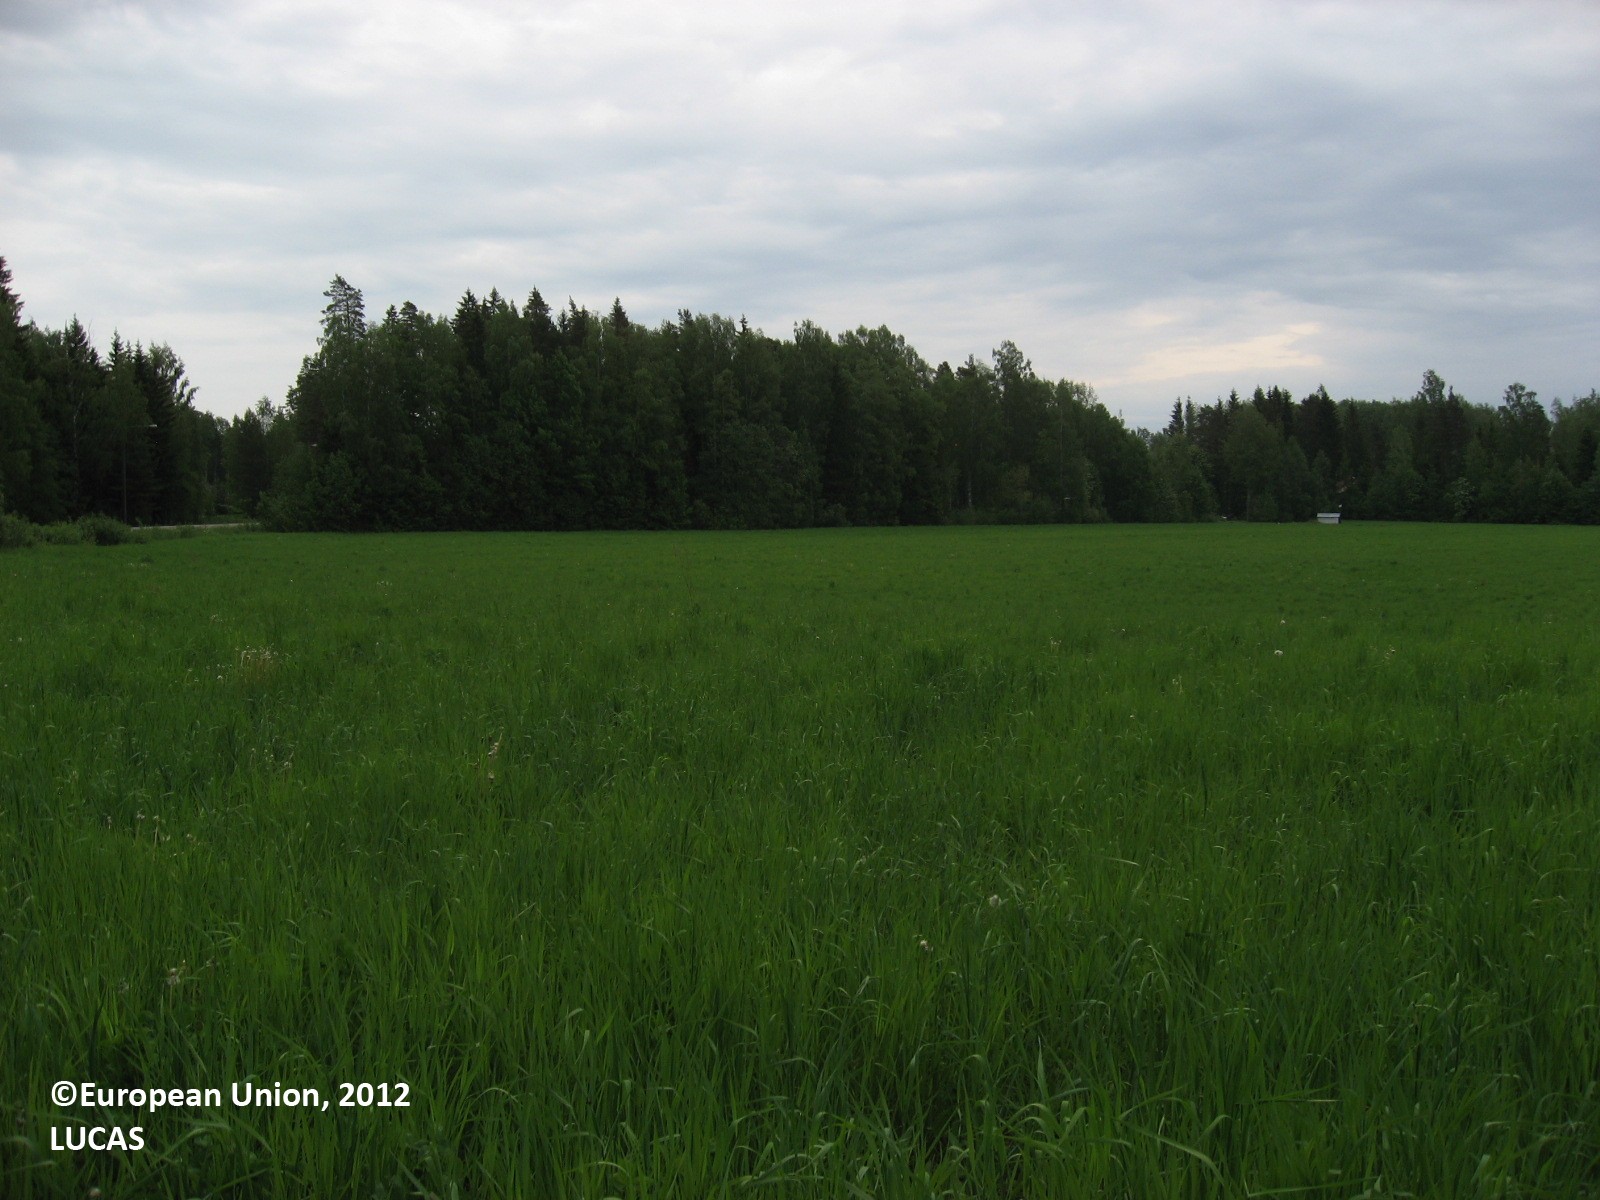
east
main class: Cropland
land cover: Other leguminous and mixtures for fodder
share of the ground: > 75 %
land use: Agriculture (excluding fallow land and kitchen gardens)
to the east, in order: Other leguminous and mixtures for fodder; Spruce dominated mixed woodland
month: June
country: FI
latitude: 60.4065
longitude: 24.9481
